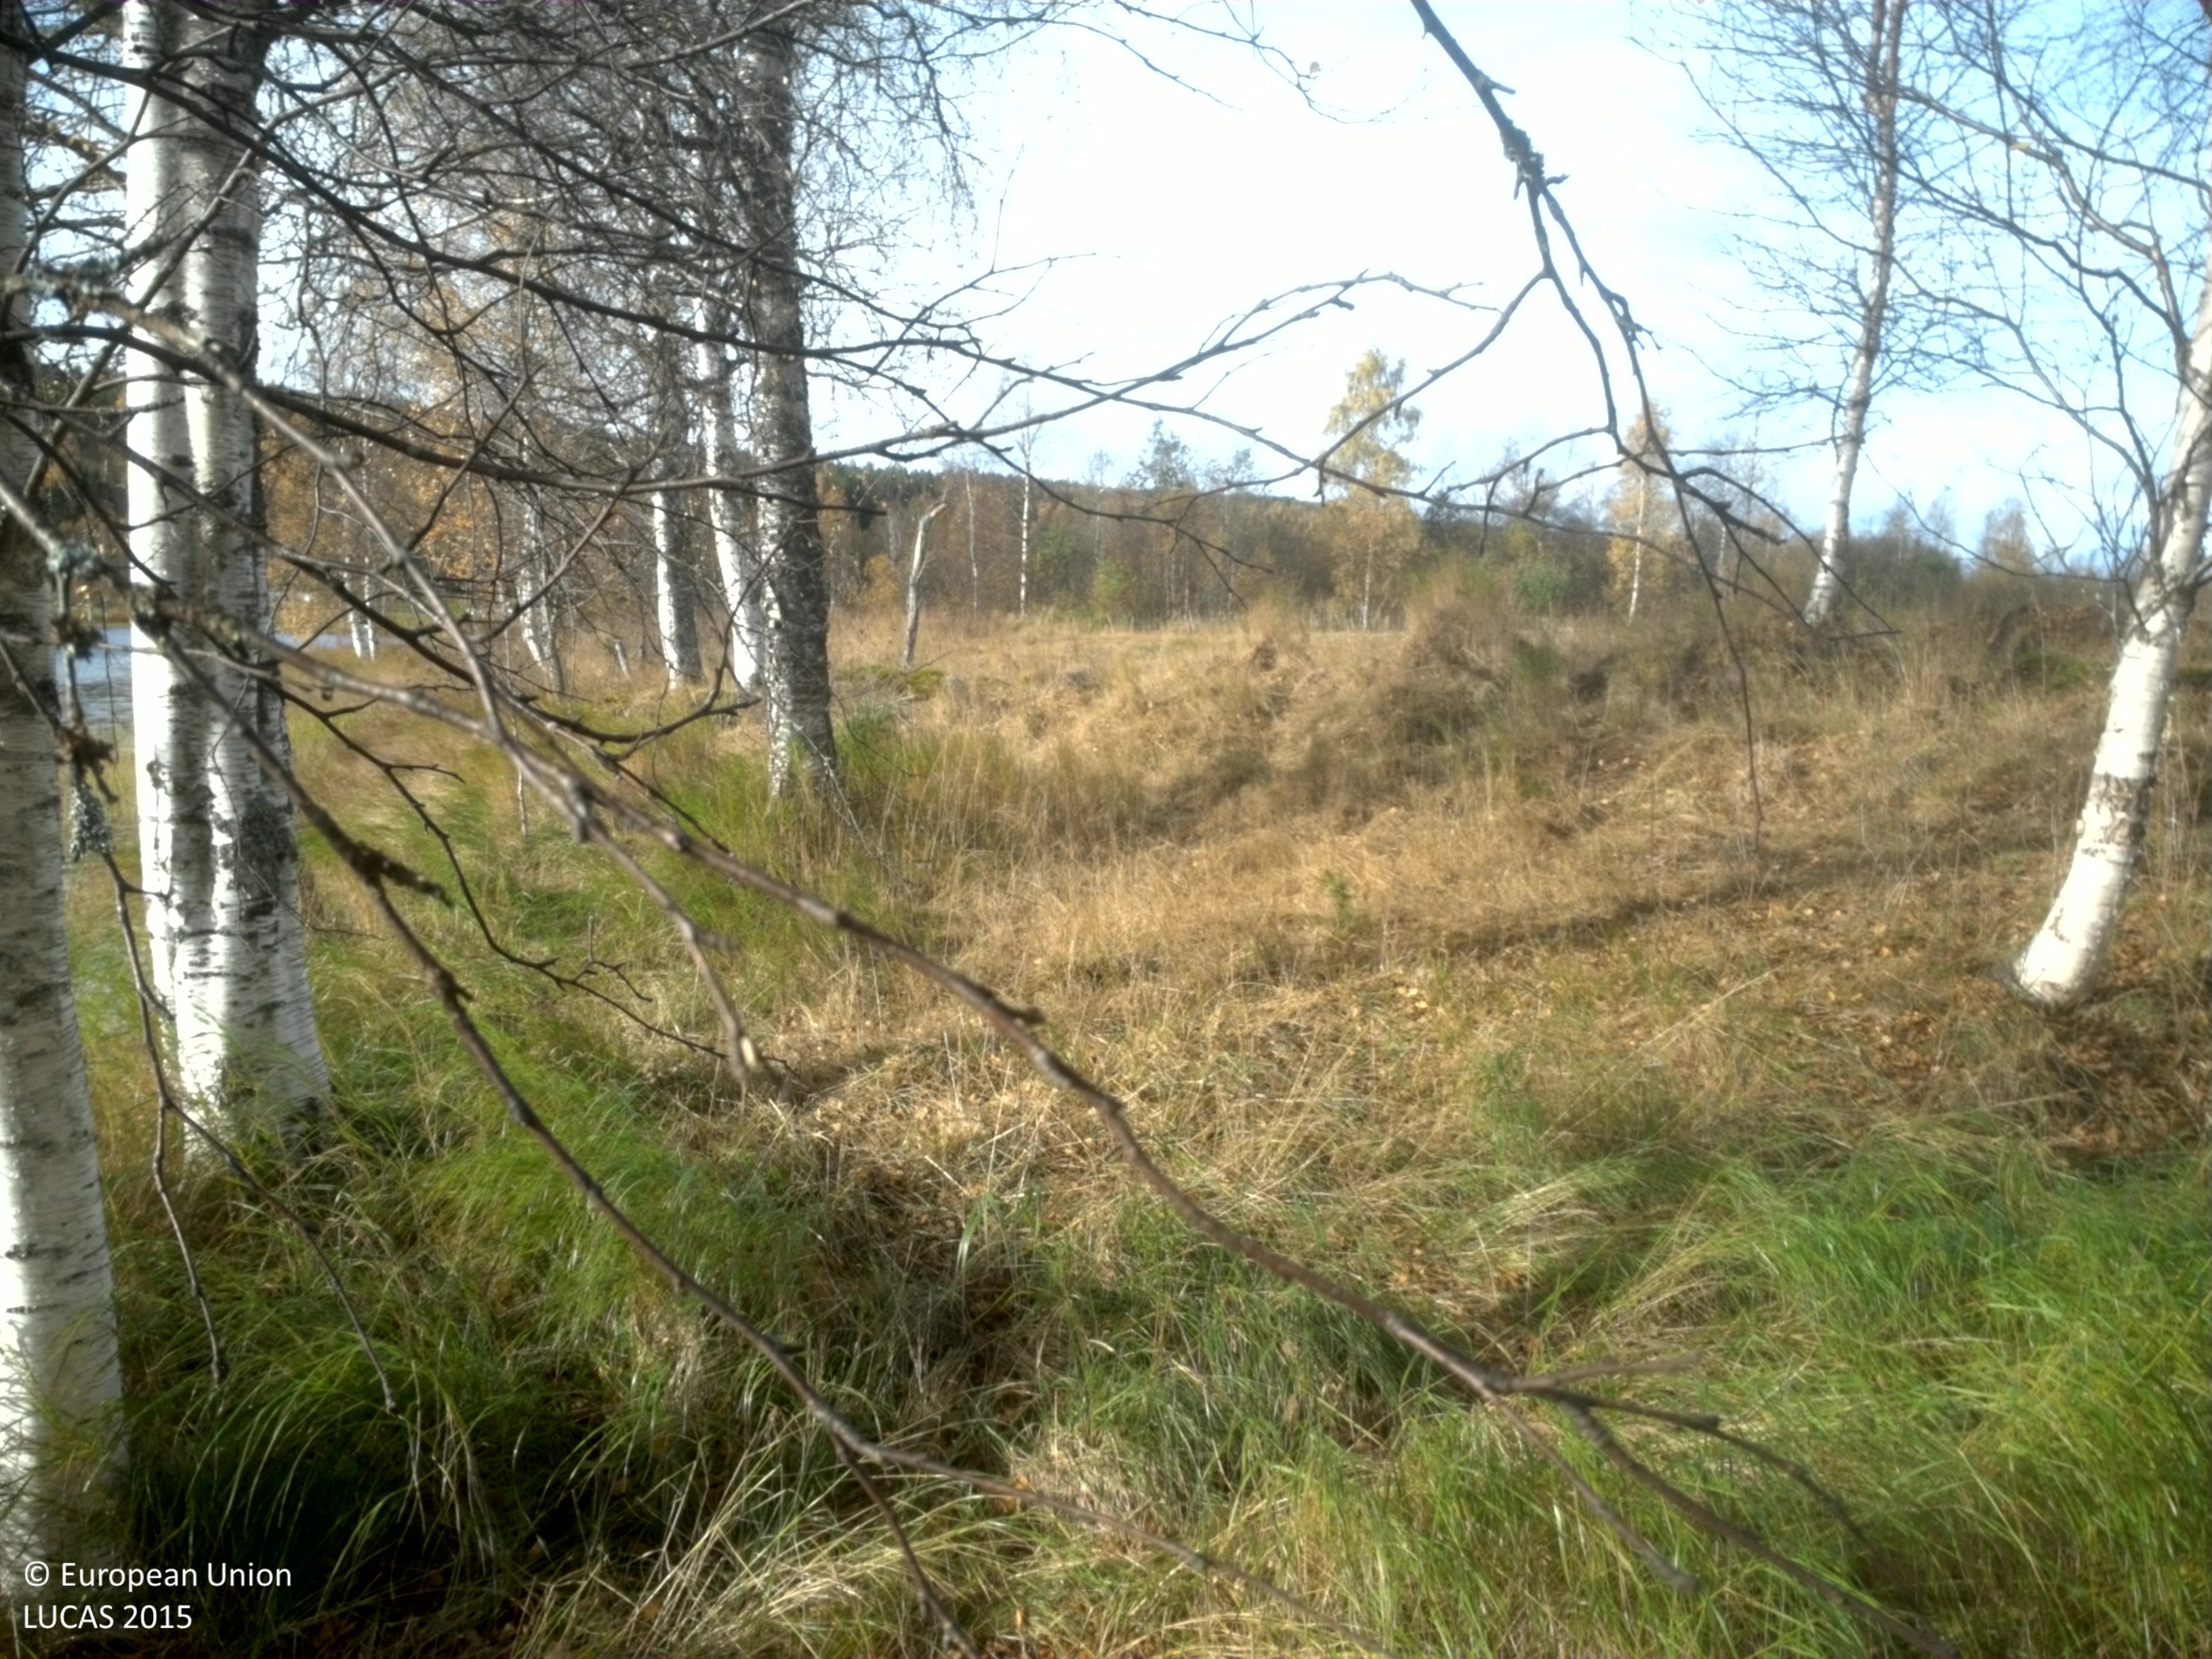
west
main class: Woodland
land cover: Broadleaved woodland
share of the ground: 25 - 50 %
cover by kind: herbaceous plants 60 %, broadleaved forest trees 40 %
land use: Semi-natural and natural areas not in use
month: October
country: SE
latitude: 64.0790
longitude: 20.0455
